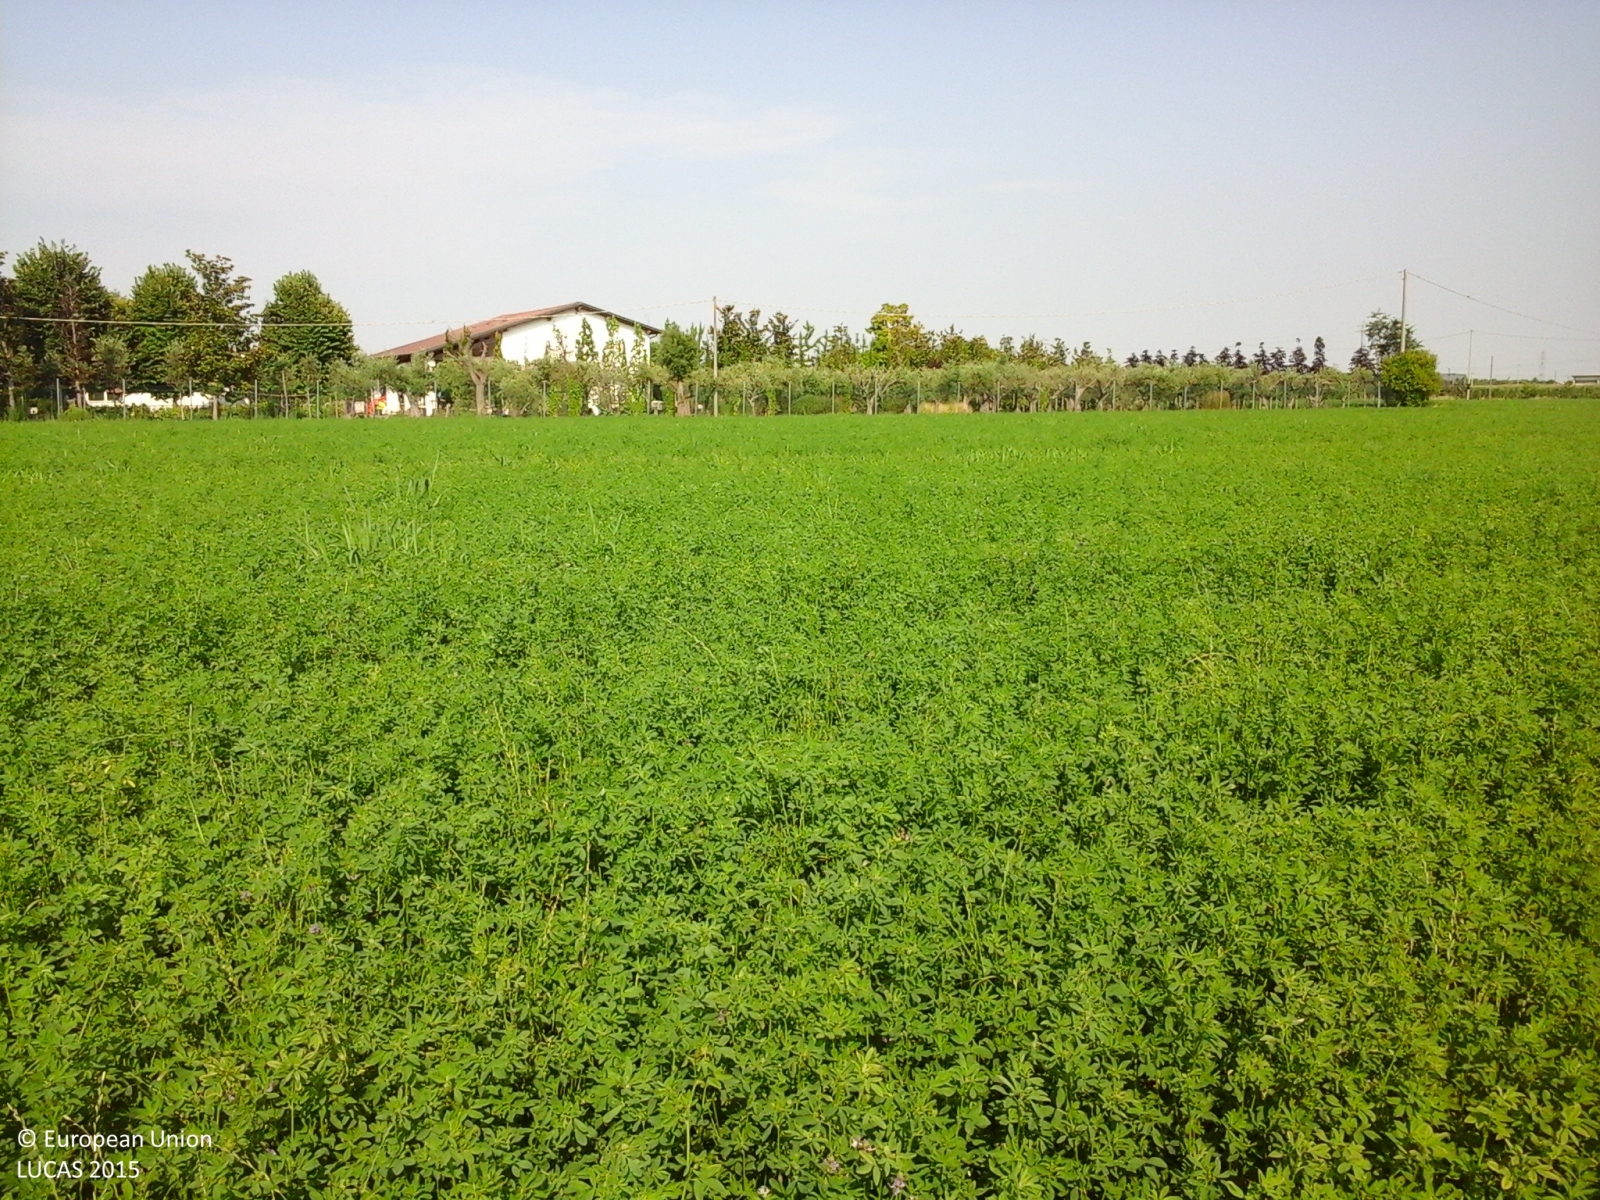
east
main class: Cropland
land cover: Lucerne
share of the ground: > 75 %
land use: Agriculture (excluding fallow land and kitchen gardens)
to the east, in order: Lucerne; Electric lines; Fences; Nurseries; Tracks; Nurseries; Grassland without tree/shrub cover; Fences; Other fruit trees and berries
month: July
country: IT
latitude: 45.3746
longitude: 10.8795
